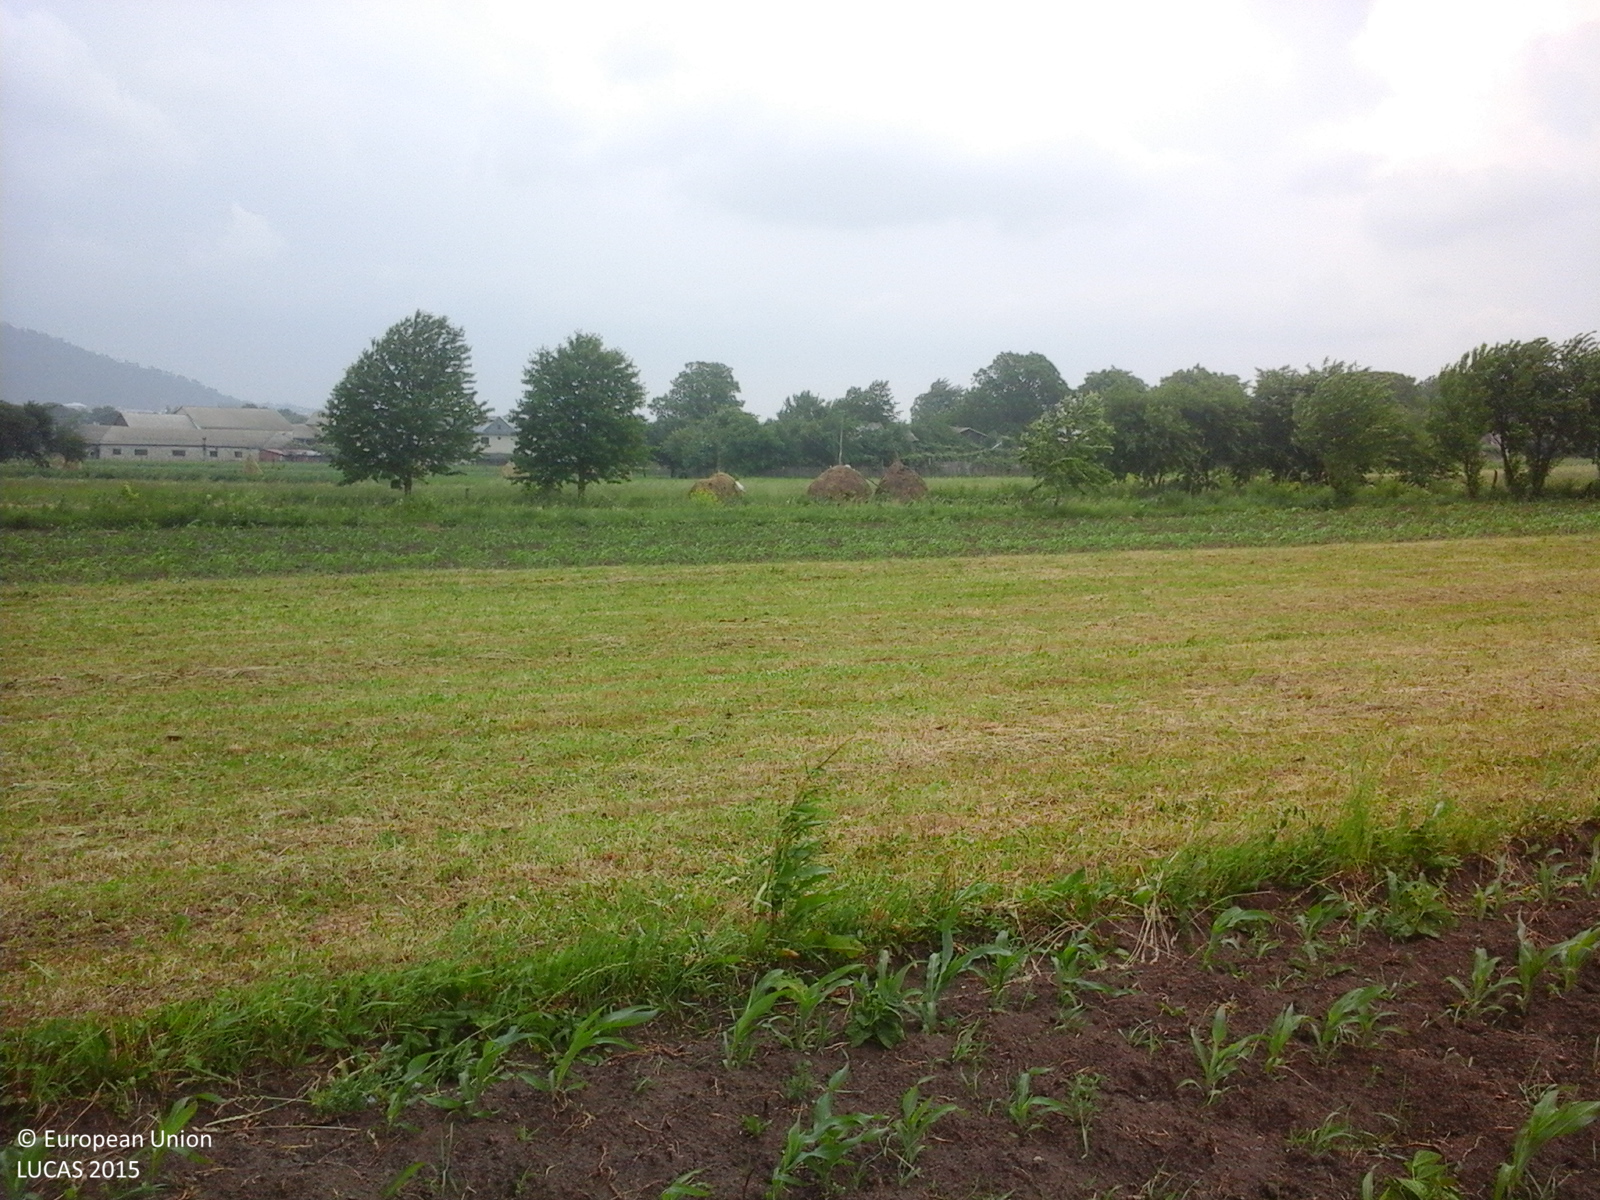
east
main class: Cropland
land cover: Maize
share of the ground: 10 - 25 %
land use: Agriculture (excluding fallow land and kitchen gardens)
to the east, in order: Maize; Other leguminous and mixtures for fodder; Maize; Grass margins; Lines of trees; Grassland without tree/shrub cover; Lines of trees; Grassland without tree/shrub cover; Maize; Grass margins; Lucerne; Ditches and canals; Grassland without tree/shrub cover; Other leguminous and mixtures for fodder; Maize; Potatoes; Grass margins; Artificial constructions in urban areas
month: June
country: RO
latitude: 47.1967
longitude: 26.3310
